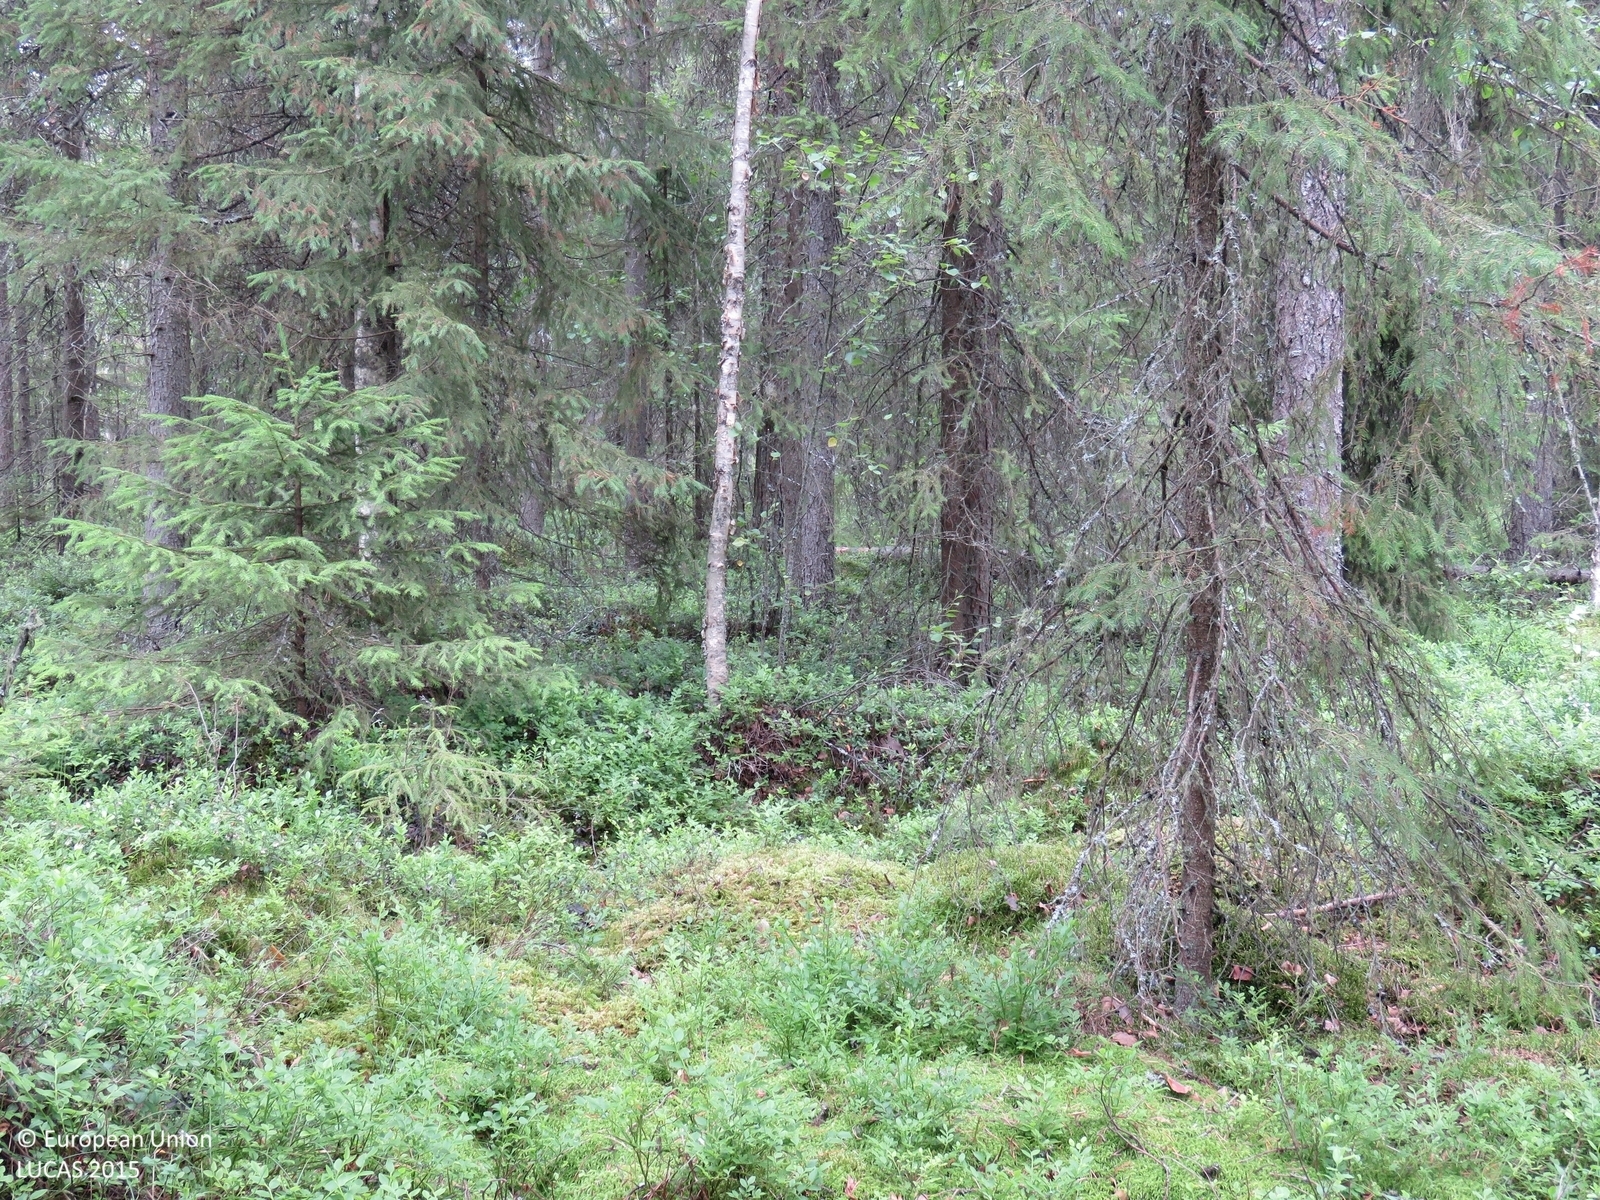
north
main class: Woodland
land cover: Spruce dominated coniferous woodland
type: boreal forest
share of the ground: > 75 %
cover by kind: coniferous forest trees 75 %, shrubs 15 %, broadleaved forest trees 10 %
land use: Forestry
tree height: > 5 m
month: July
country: FI
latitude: 64.4686
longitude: 26.5225
